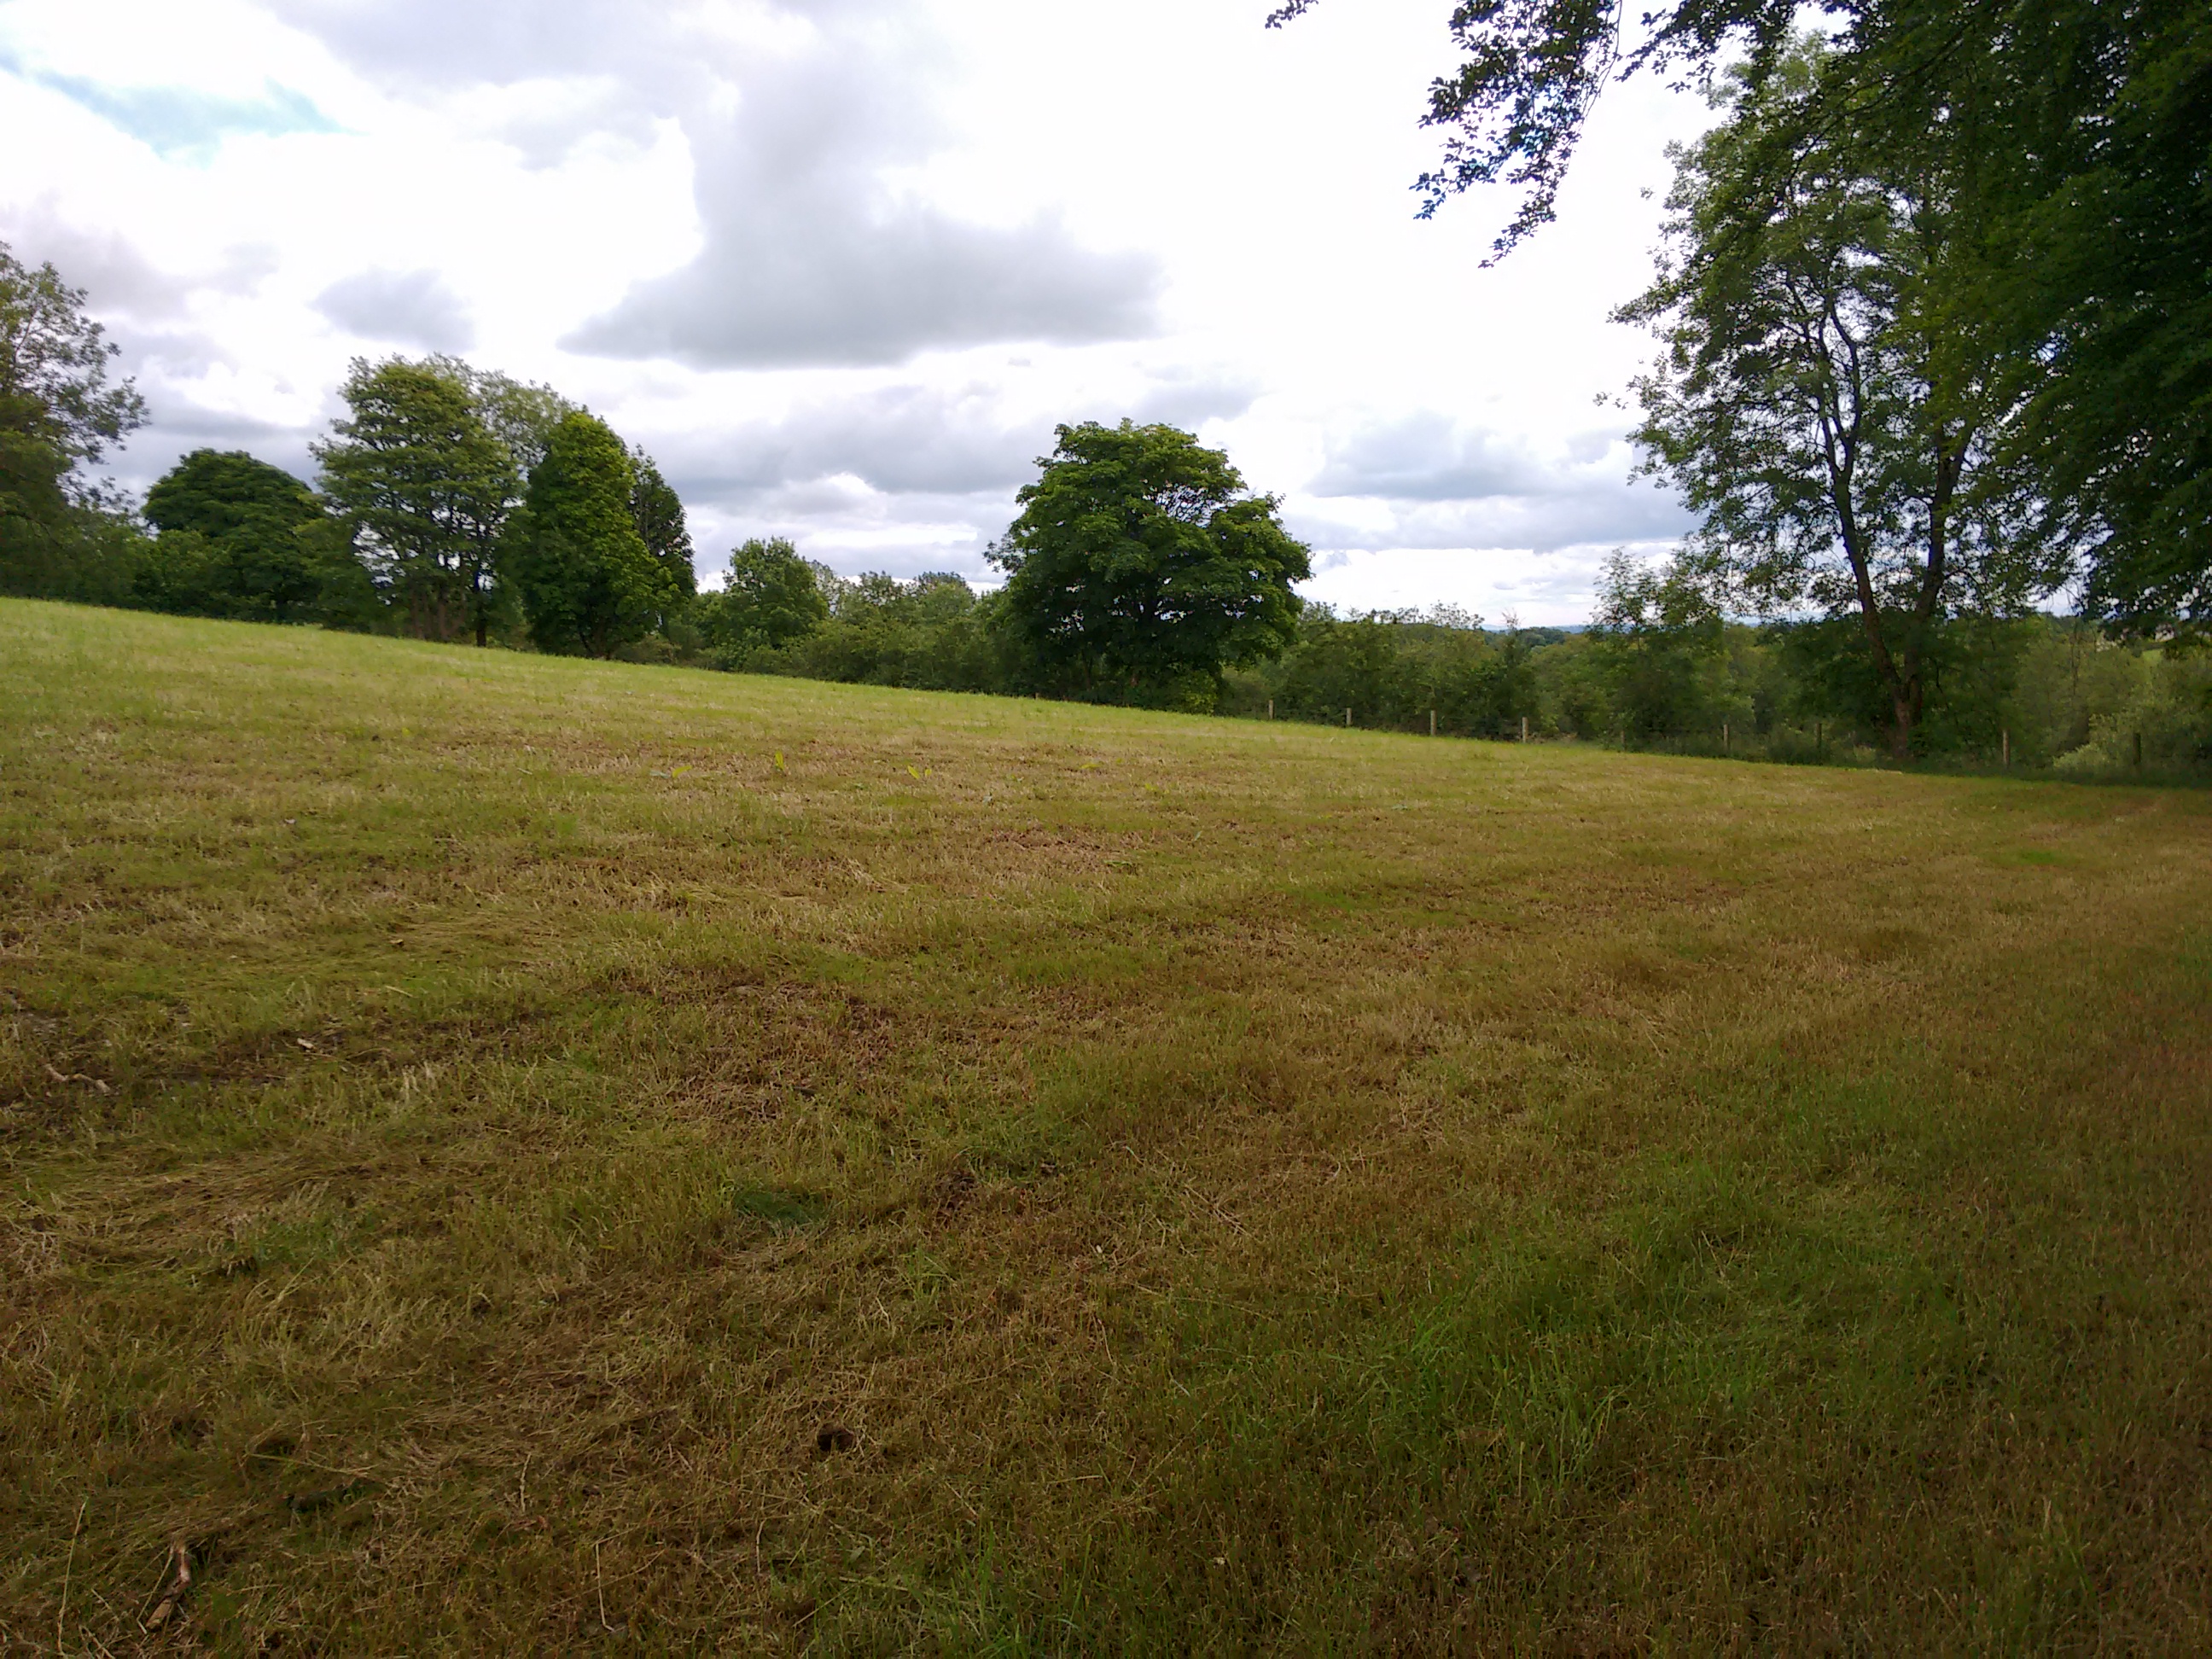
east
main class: Woodland
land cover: Broadleaved woodland
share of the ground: 25 - 50 %
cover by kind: herbaceous plants 50 %, broadleaved forest trees 40 %, shrubs 10 %
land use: Agriculture (excluding fallow land and kitchen gardens)
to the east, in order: Broadleaved woodland; Fences; Oats; Grass margins; Fences; Lines of trees; Ditches and canals; Rock outcrops; Grassland without tree/shrub cover; Ditches and canals; Abandoned hedges; Grassland without tree/shrub cover; Fences; Managed hedges; Grass margins; Paved roads, cycling and walking lanes; Grass margins; Managed hedges; Fences; Grassland without tree/shrub cover; Rock outcrops; Abandoned hedges; Grassland without tree/shrub cover
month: July
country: GB
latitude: 54.6762
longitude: -6.8363
